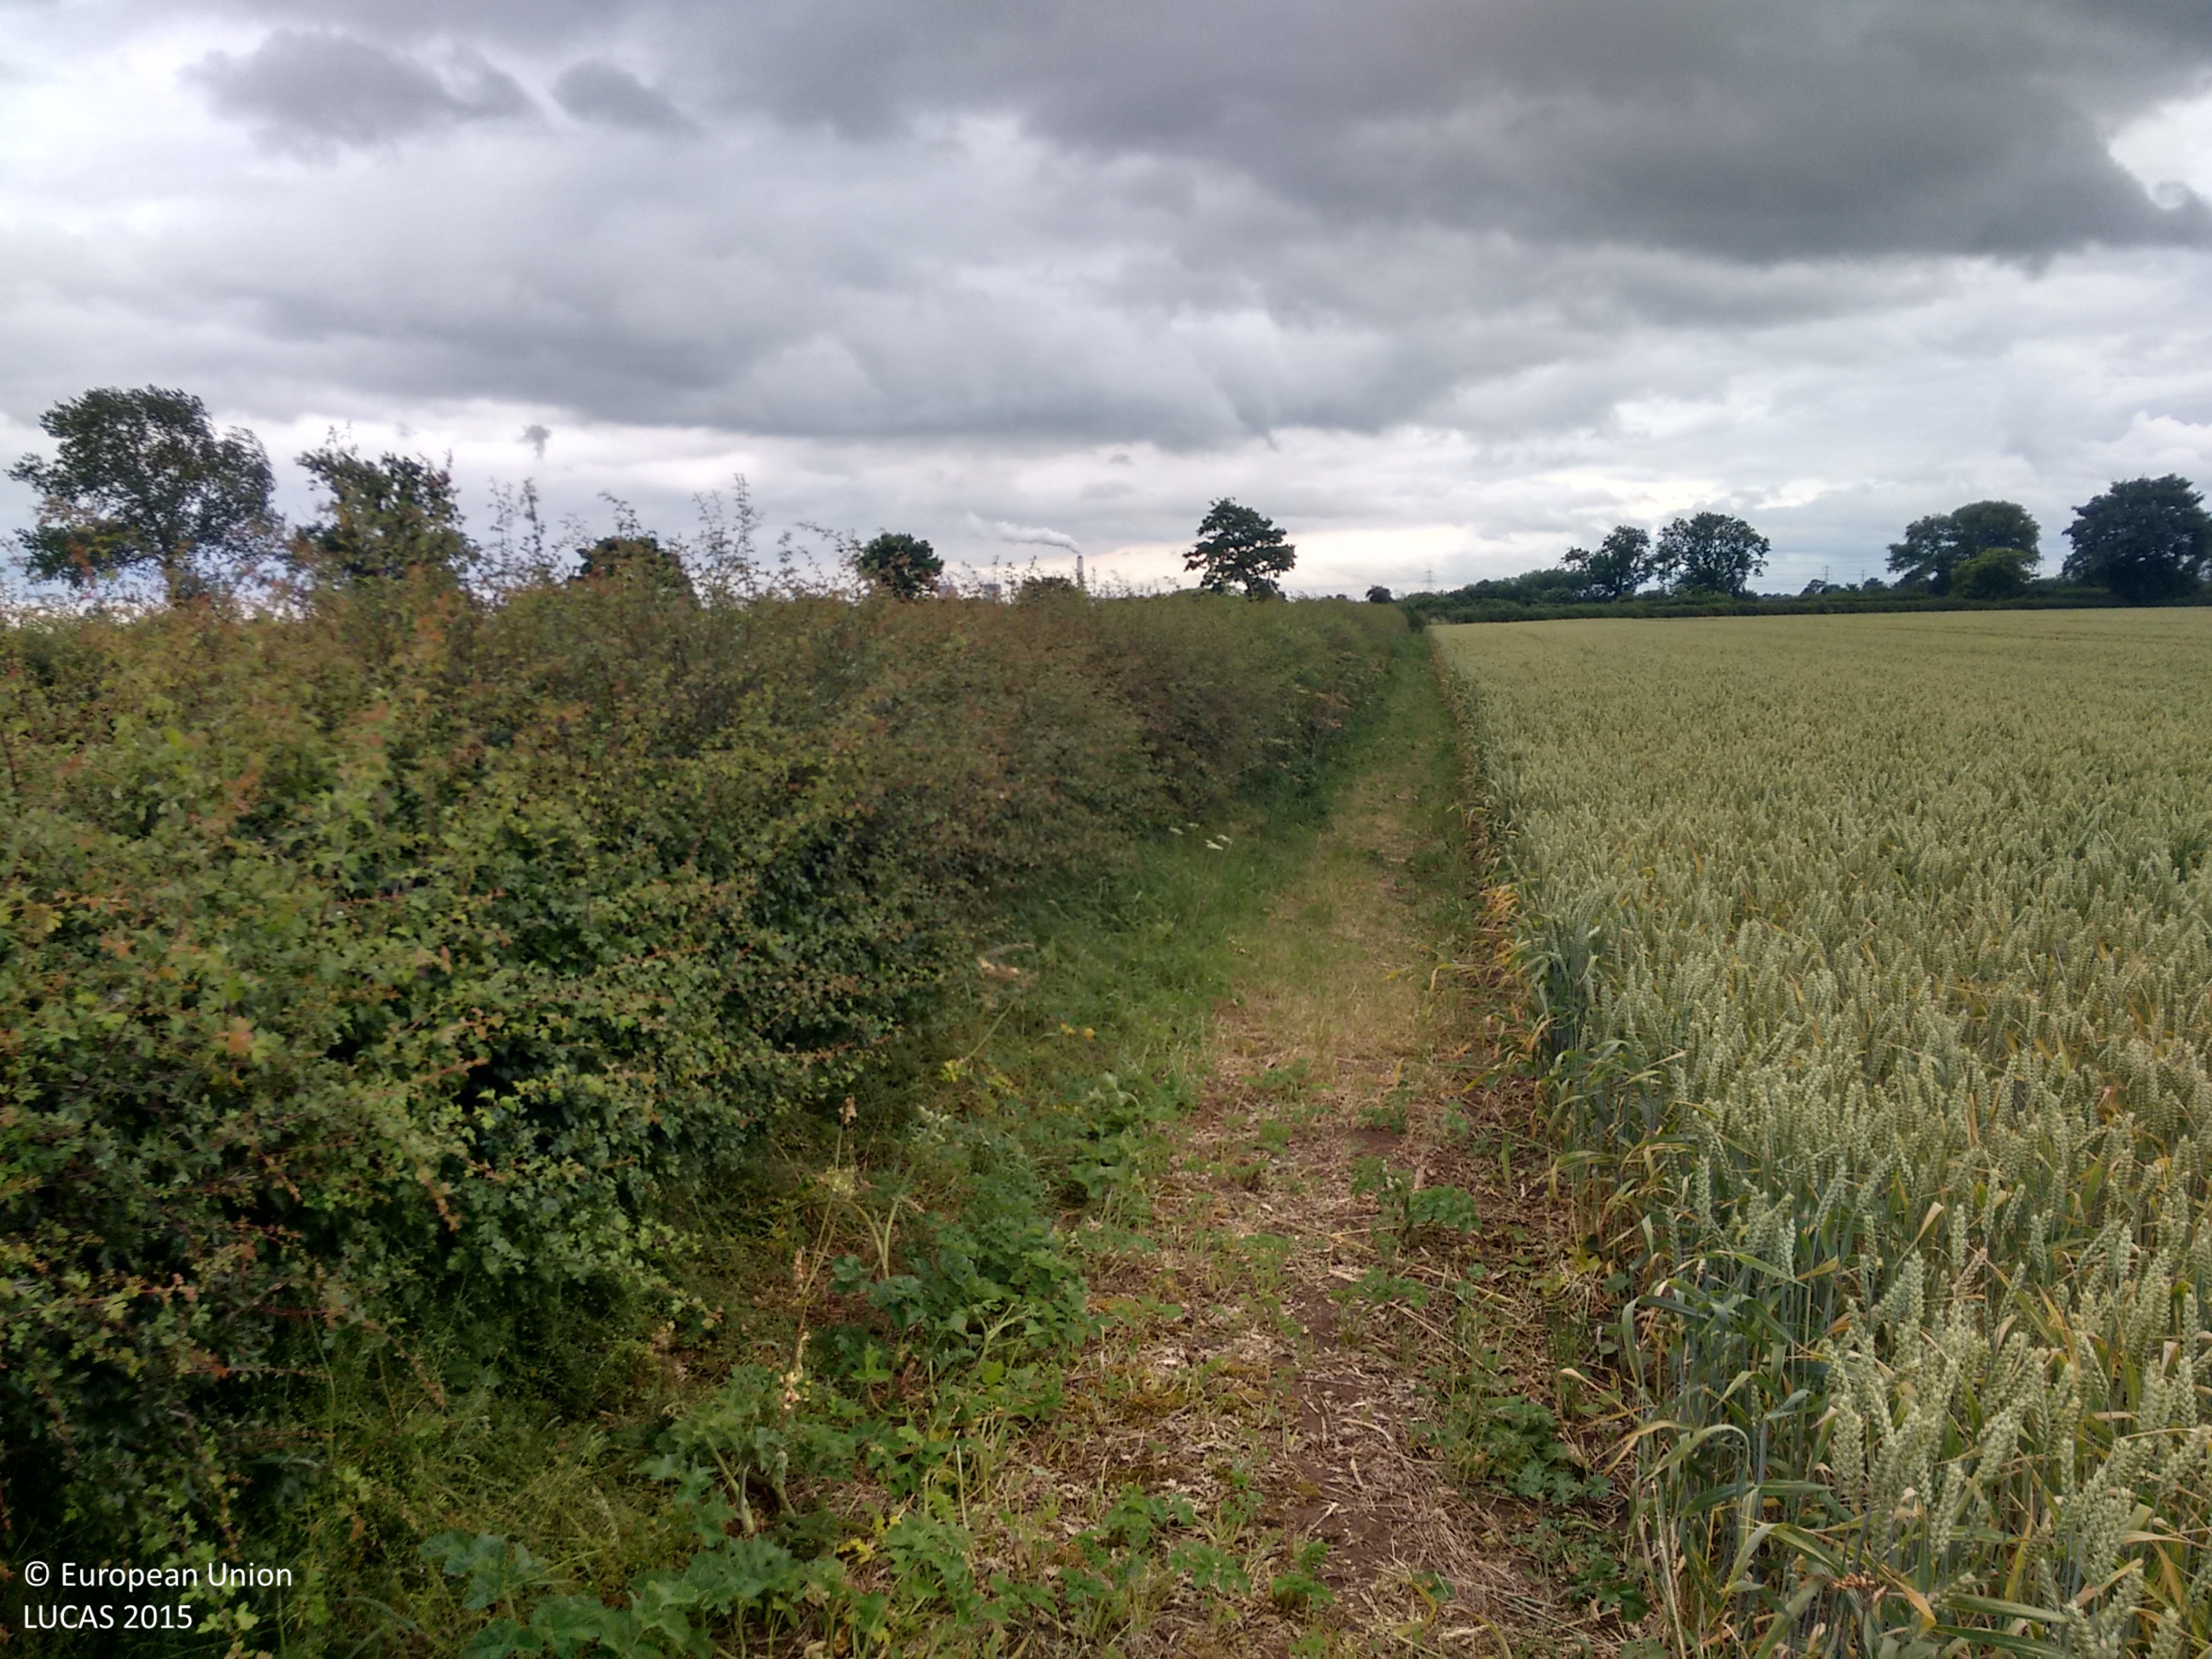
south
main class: Cropland
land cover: Common wheat
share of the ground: > 75 %
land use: Agriculture (excluding fallow land and kitchen gardens)
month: July
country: GB
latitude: 53.3544
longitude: -0.7829
